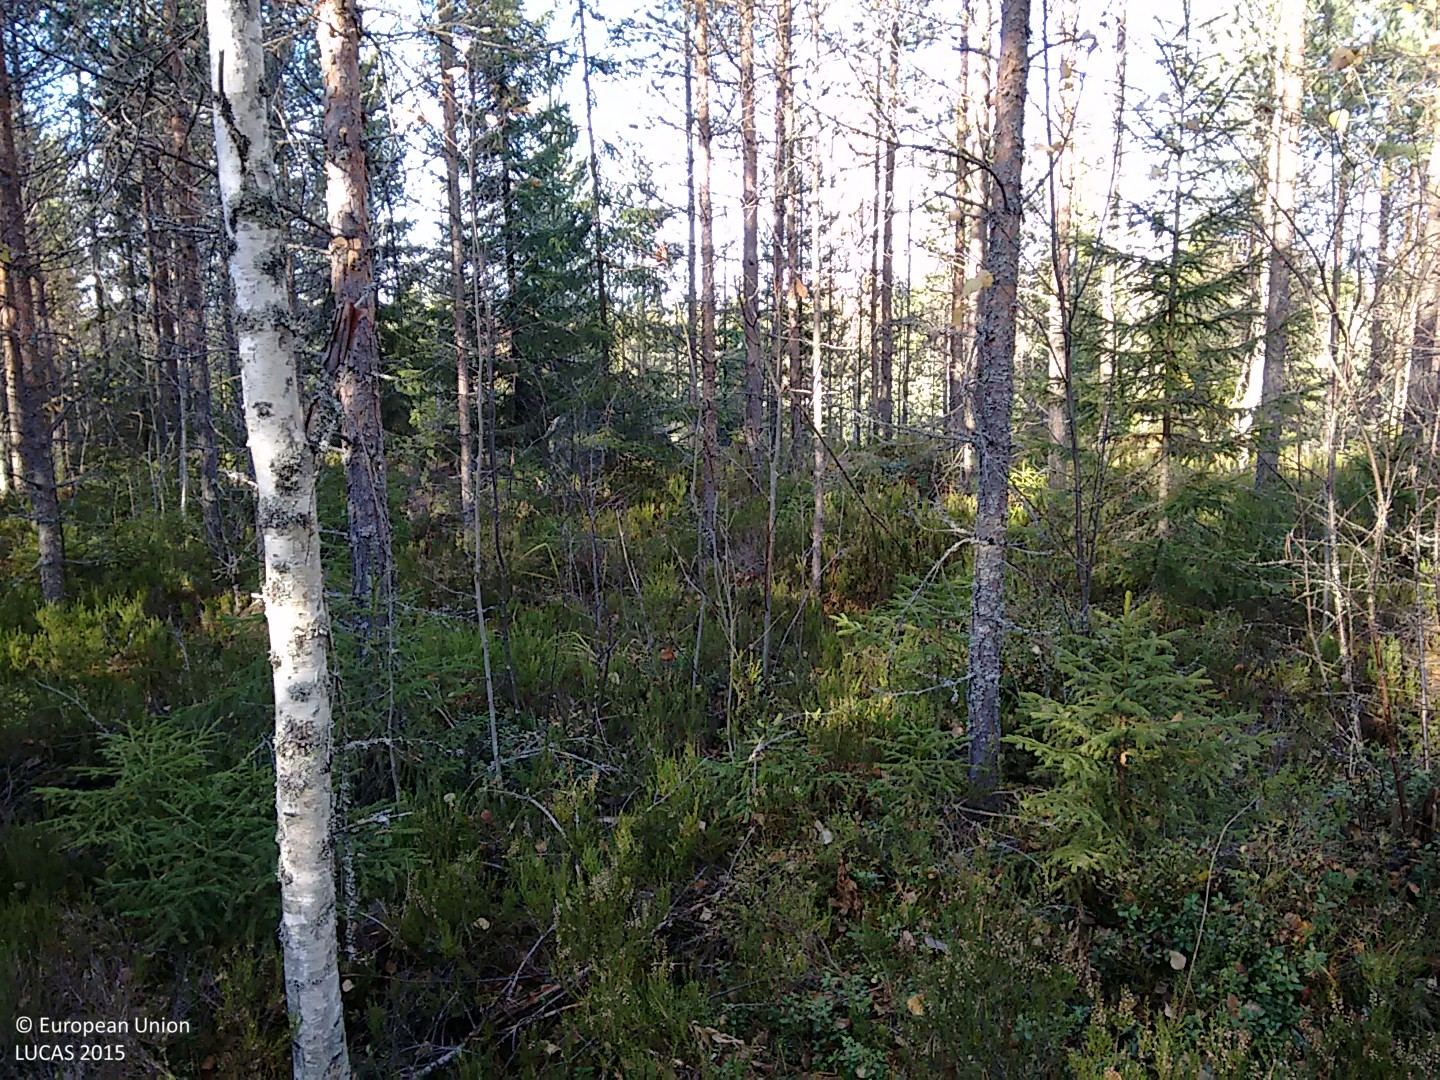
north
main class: Woodland
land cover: Pine dominated mixed woodland
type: hemiboreal forest and nemoral coniferous forest and mixed broadleaved-coniferous forest
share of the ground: > 75 %
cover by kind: coniferous forest trees 55 %, broadleaved forest trees 25 %, shrubs 20 %
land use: Forestry
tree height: > 5 m
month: October
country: FI
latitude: 62.6105
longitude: 25.8832
